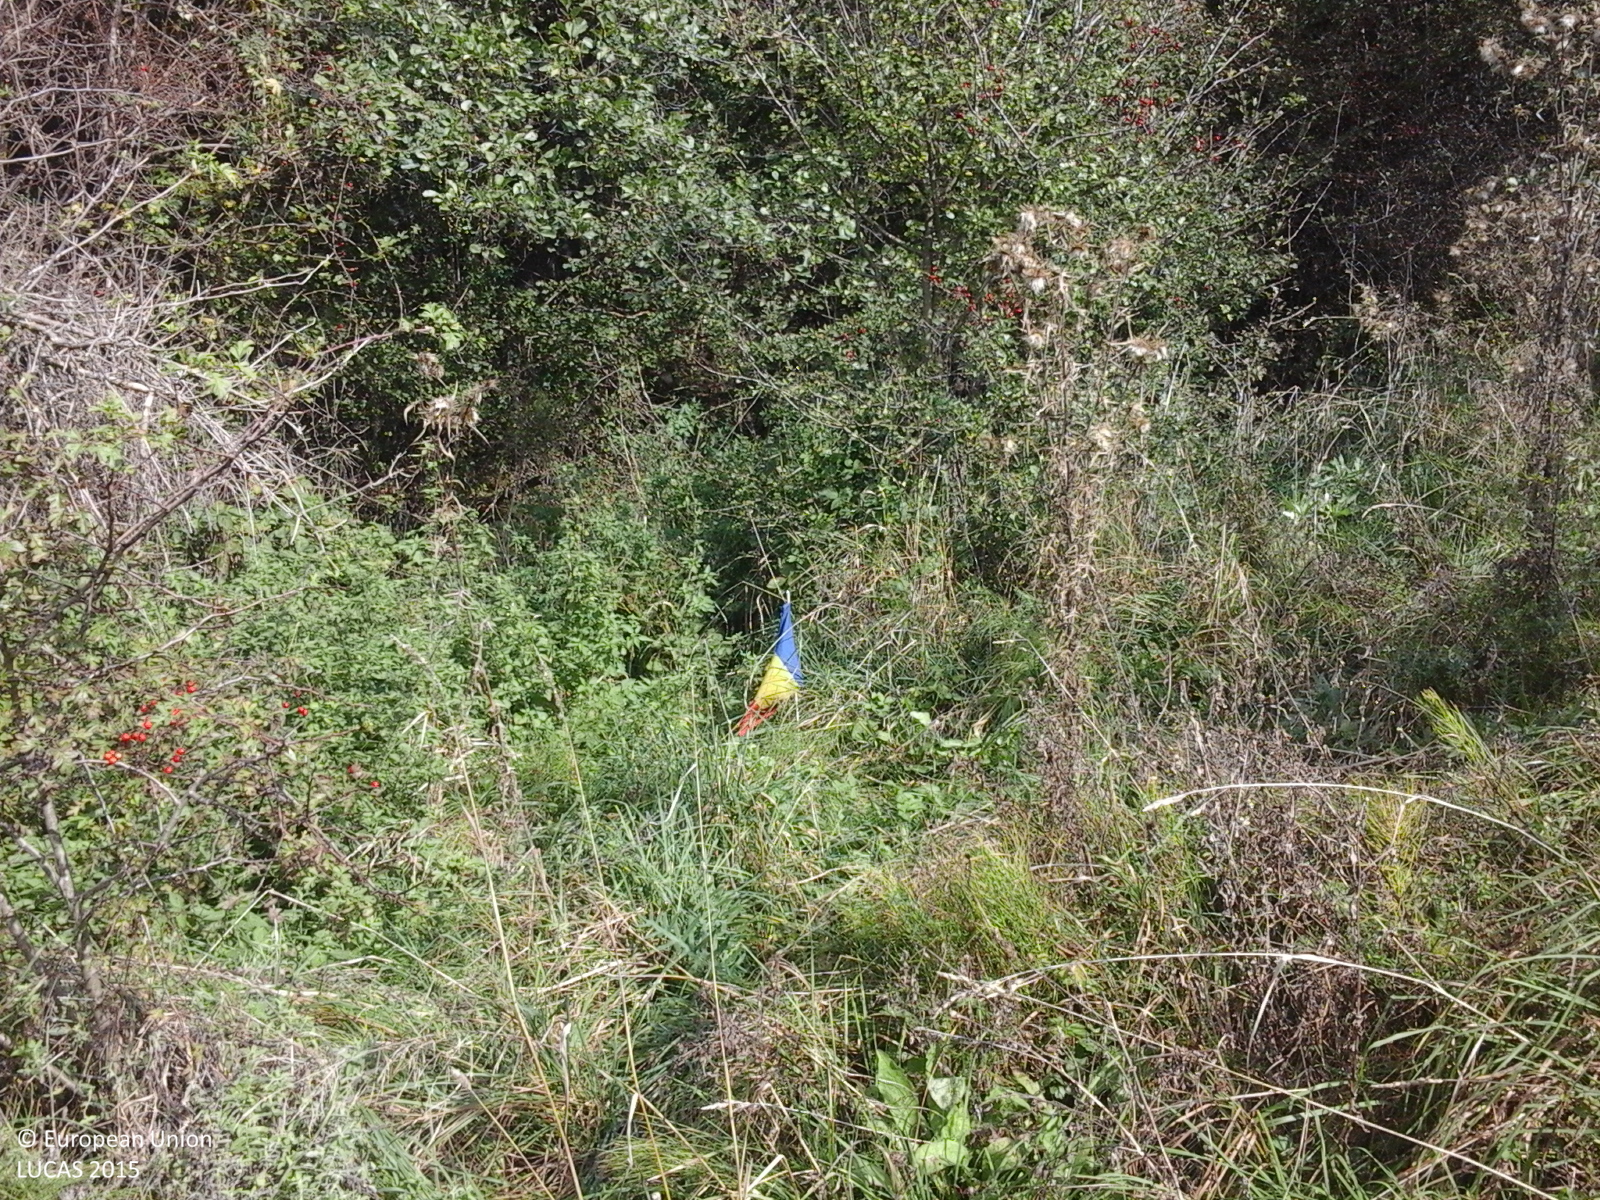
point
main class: Grassland
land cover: Grassland with sparse tree/shrub cover
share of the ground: > 75 %
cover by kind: herbaceous plants 85 %, shrubs 10 %, broadleaved forest trees 5 %
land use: Fallow land
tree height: > 5 m
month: October
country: RO
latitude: 46.4387
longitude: 25.1330
